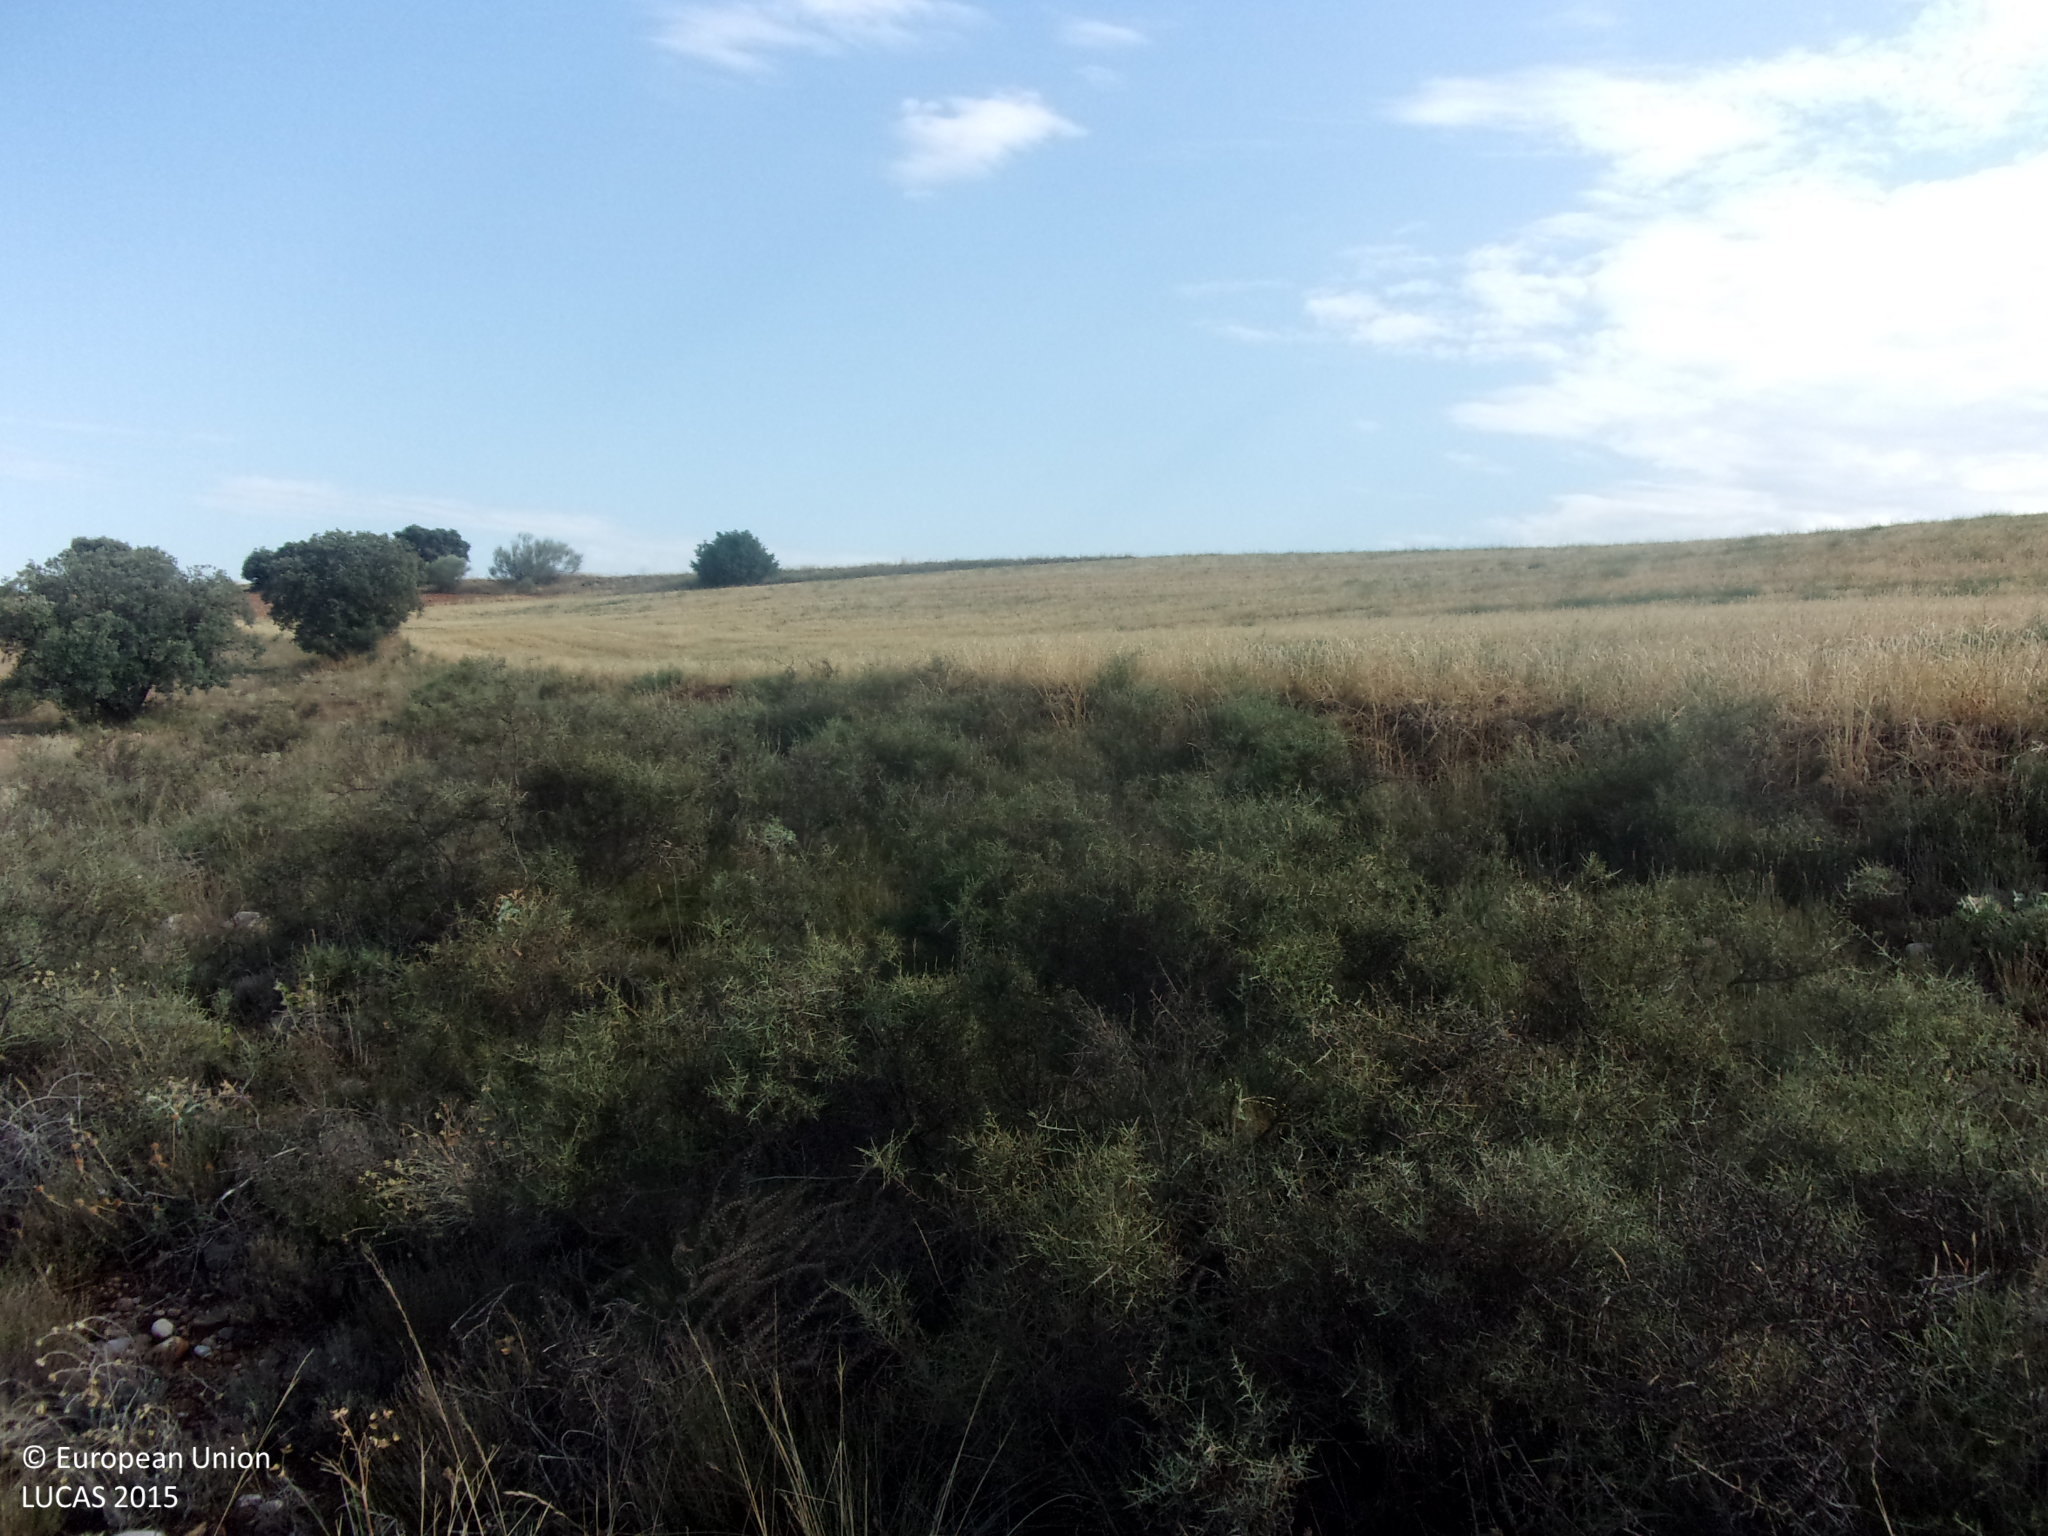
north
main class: Shrubland
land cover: Shrubland with sparse tree cover
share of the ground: > 75 %
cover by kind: shrubs 75 %, herbaceous plants 20 %, broadleaved forest trees 5 %
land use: Semi-natural and natural areas not in use
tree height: < 5 m
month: July
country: ES
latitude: 41.2358
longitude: -1.9220
